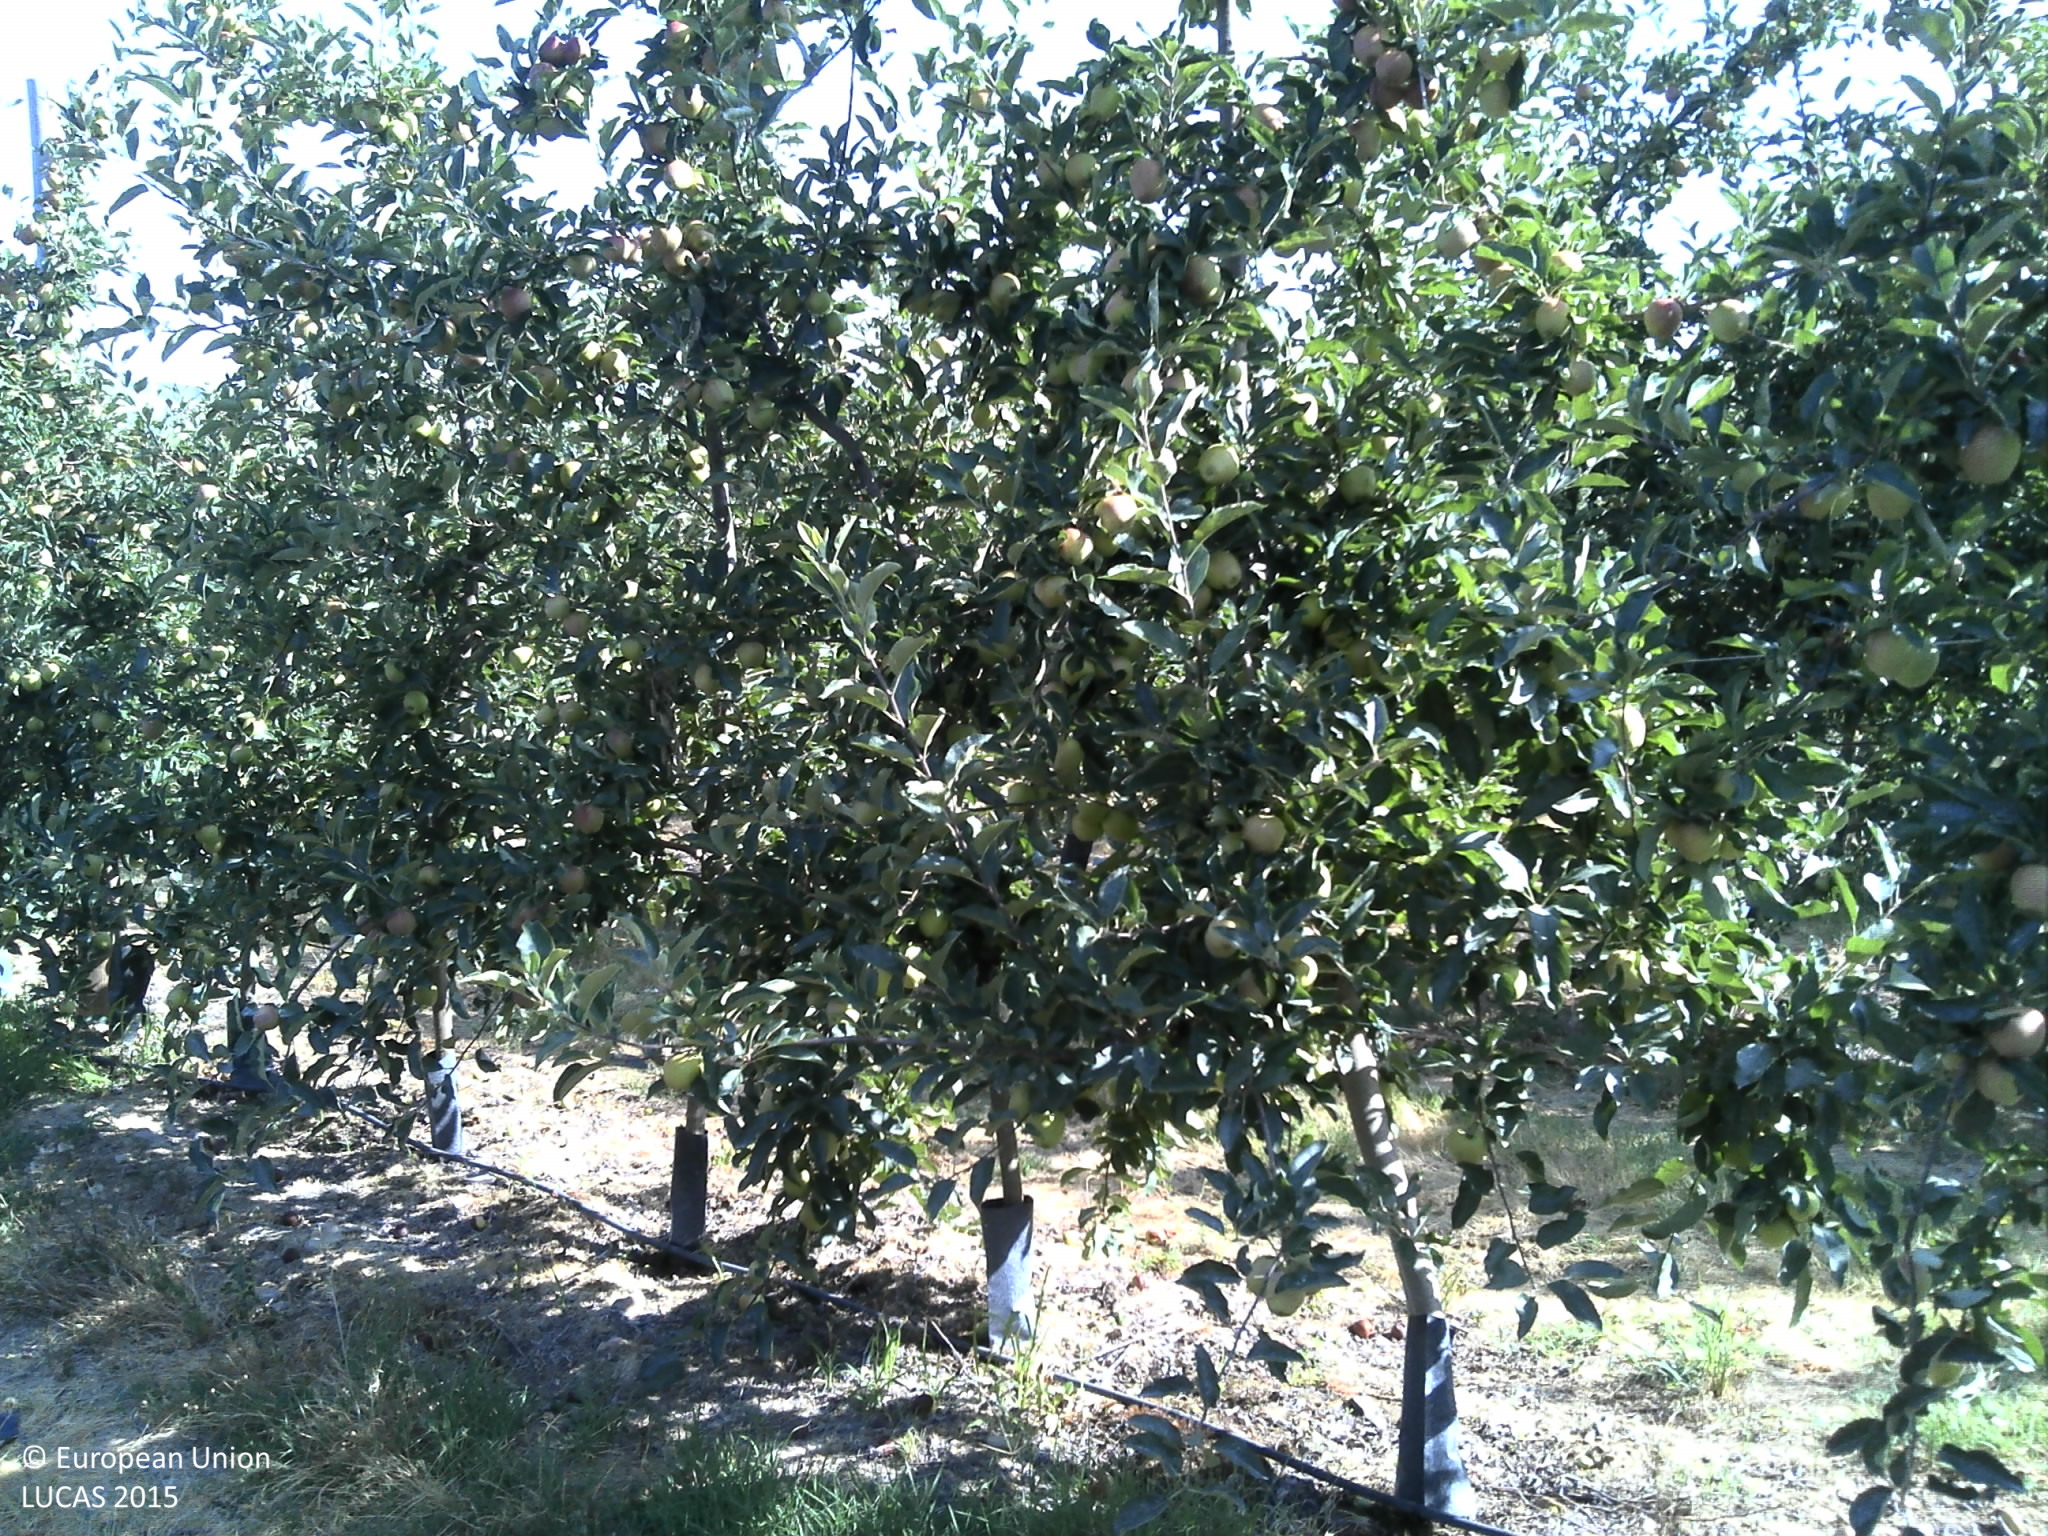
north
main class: Cropland
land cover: Apple fruit
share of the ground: 25 - 50 %
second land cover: Grassland without tree/shrub cover
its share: 10 - 25 %
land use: Agriculture (excluding fallow land and kitchen gardens)
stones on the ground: < 10 %
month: July
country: PT
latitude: 41.0509
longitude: -7.4538
